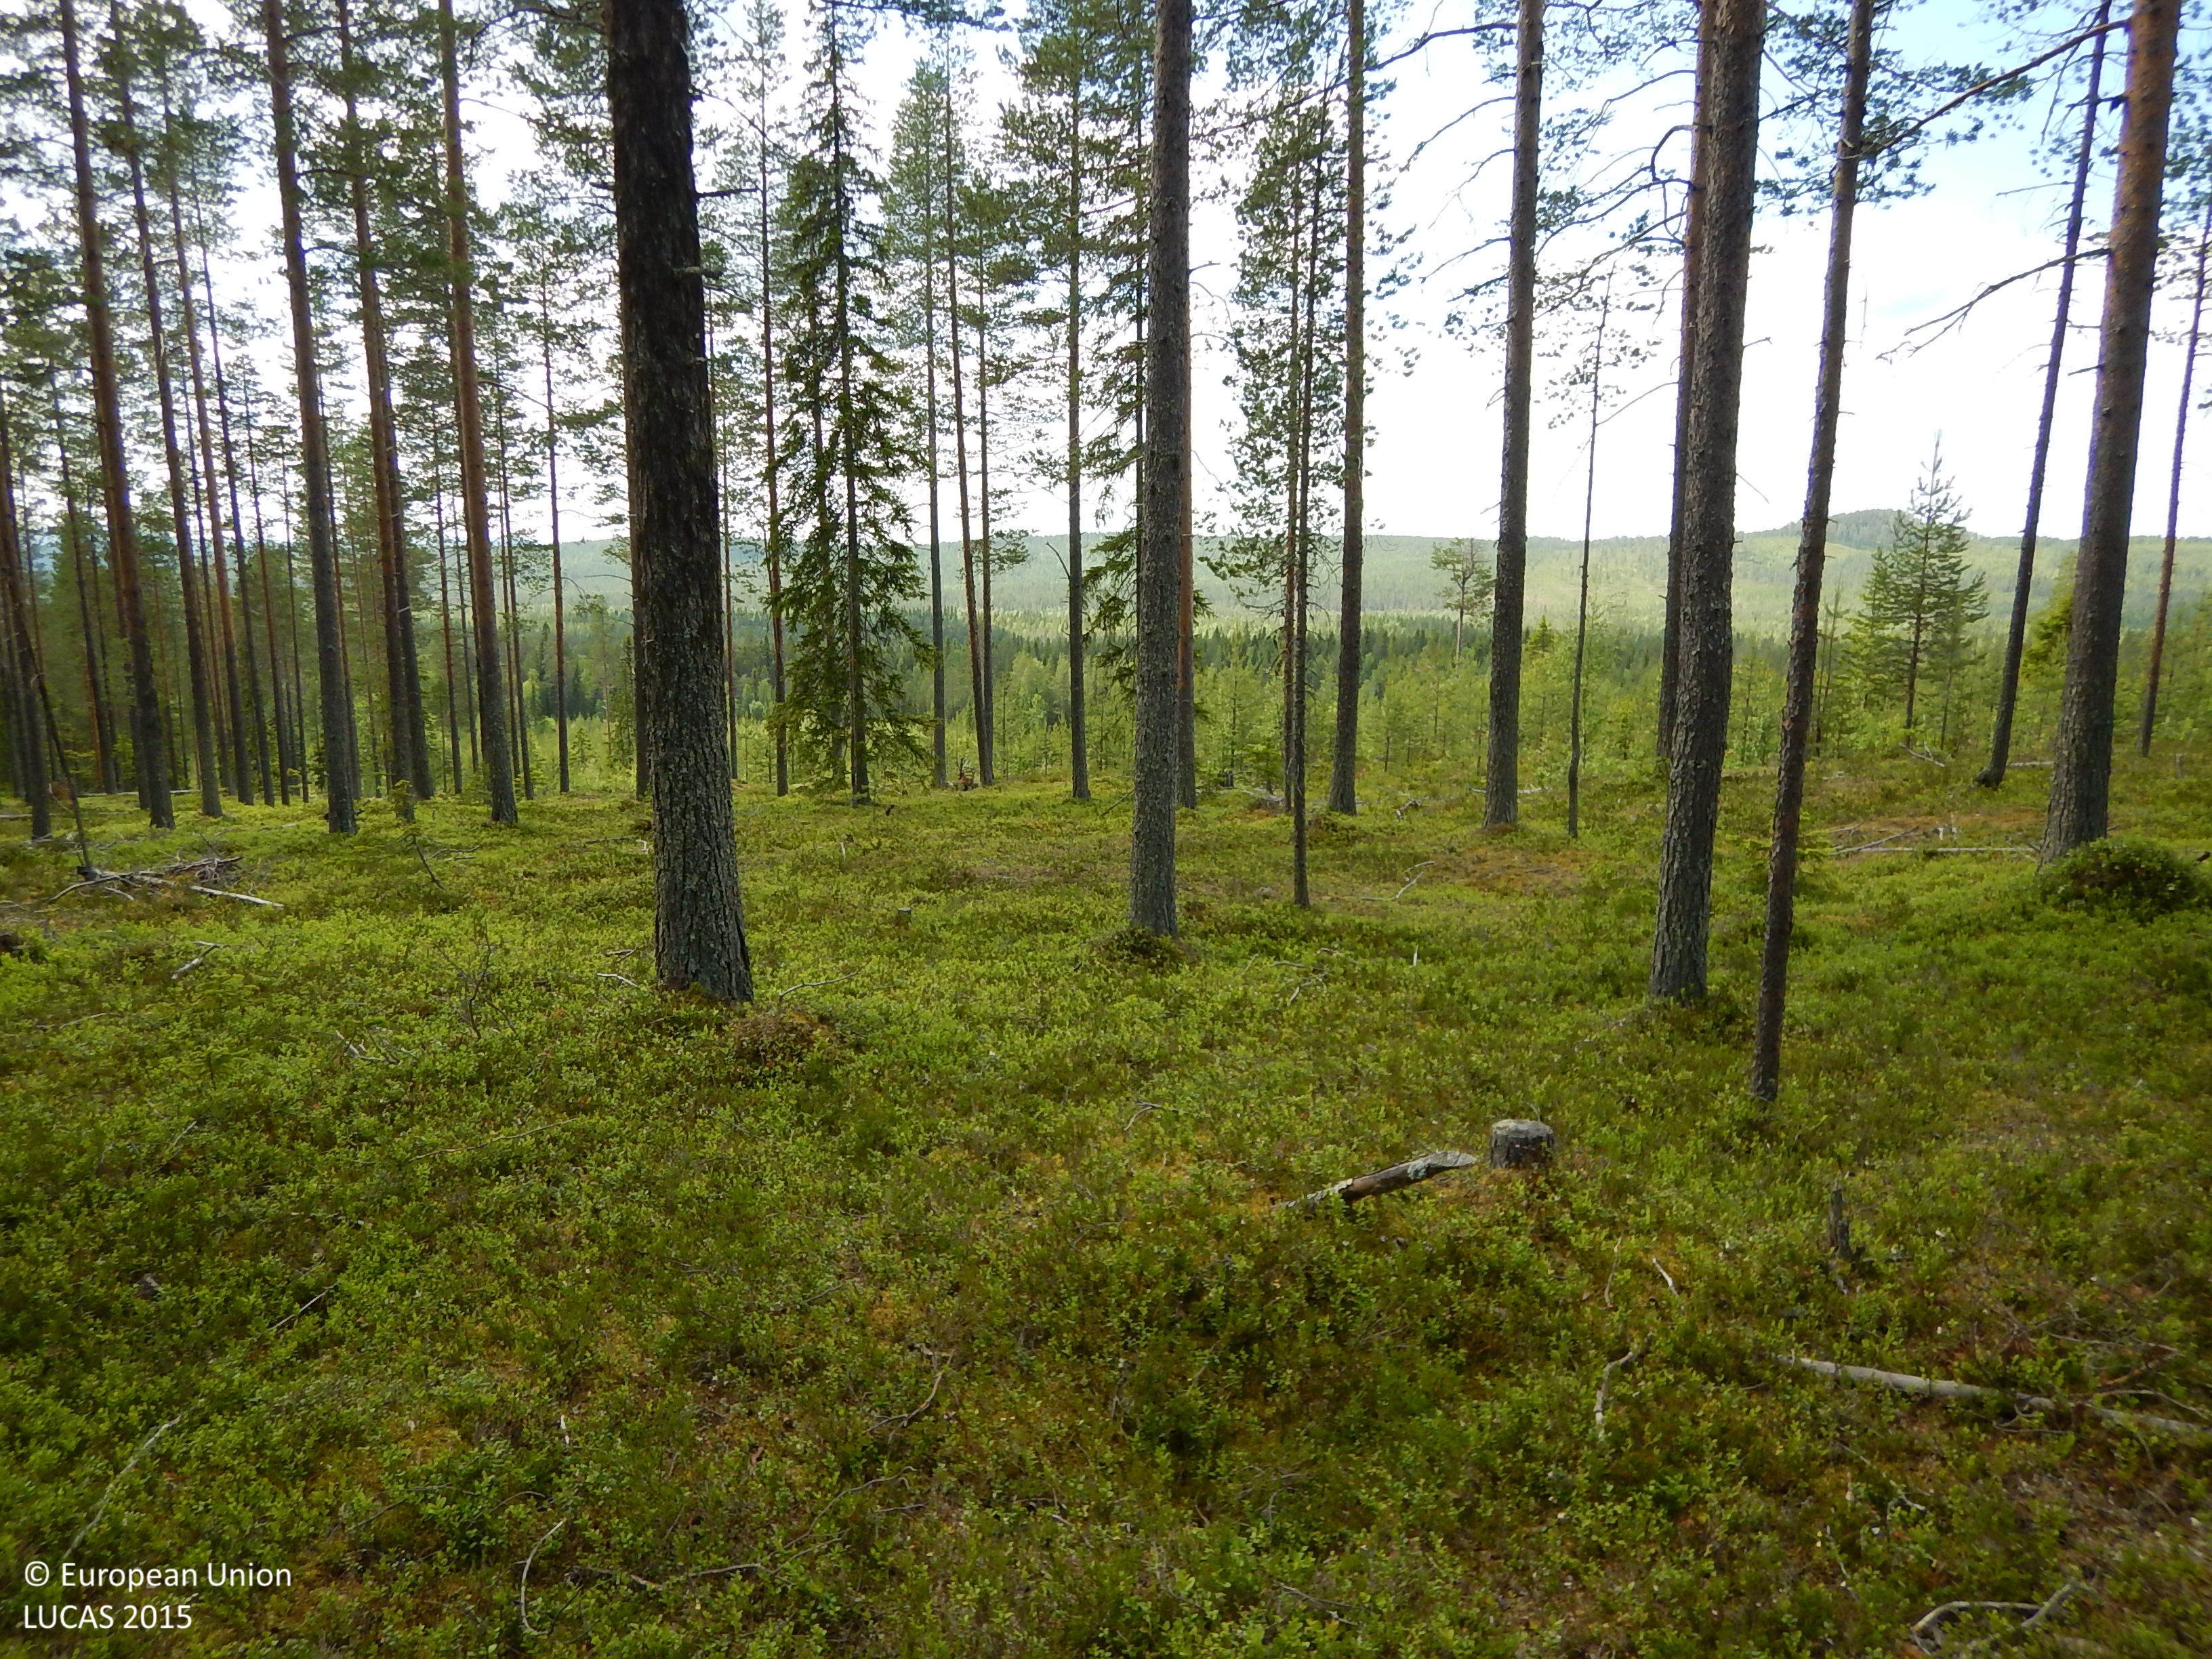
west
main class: Woodland
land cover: Pine dominated coniferous woodland
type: boreal forest
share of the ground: 50 - 75 %
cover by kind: coniferous forest trees 50 %, lichens and mosses 20 %, shrubs 15 %, herbaceous plants 15 %
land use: Forestry
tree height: > 5 m
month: July
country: SE
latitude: 65.0346
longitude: 19.9275
